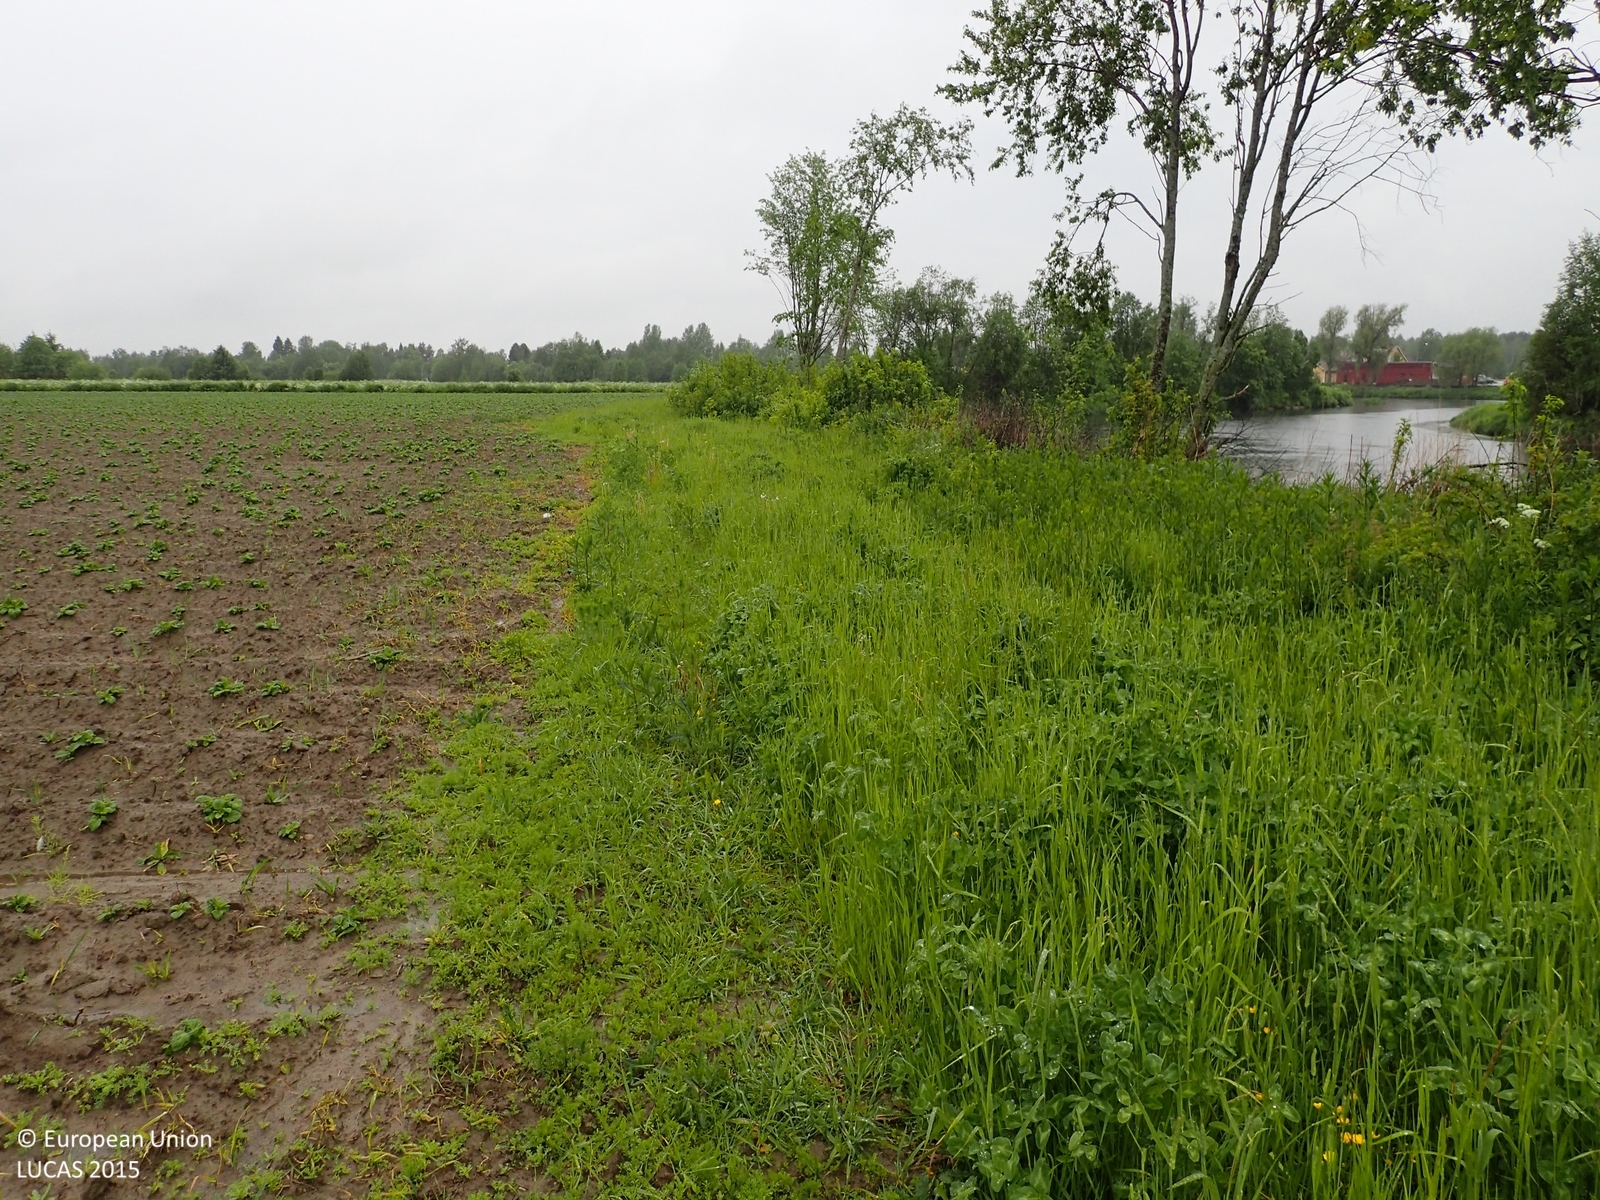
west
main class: Cropland
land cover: Potatoes
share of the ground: 10 - 25 %
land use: Agriculture (excluding fallow land and kitchen gardens)
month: June
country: FI
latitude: 62.2583
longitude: 21.5420
